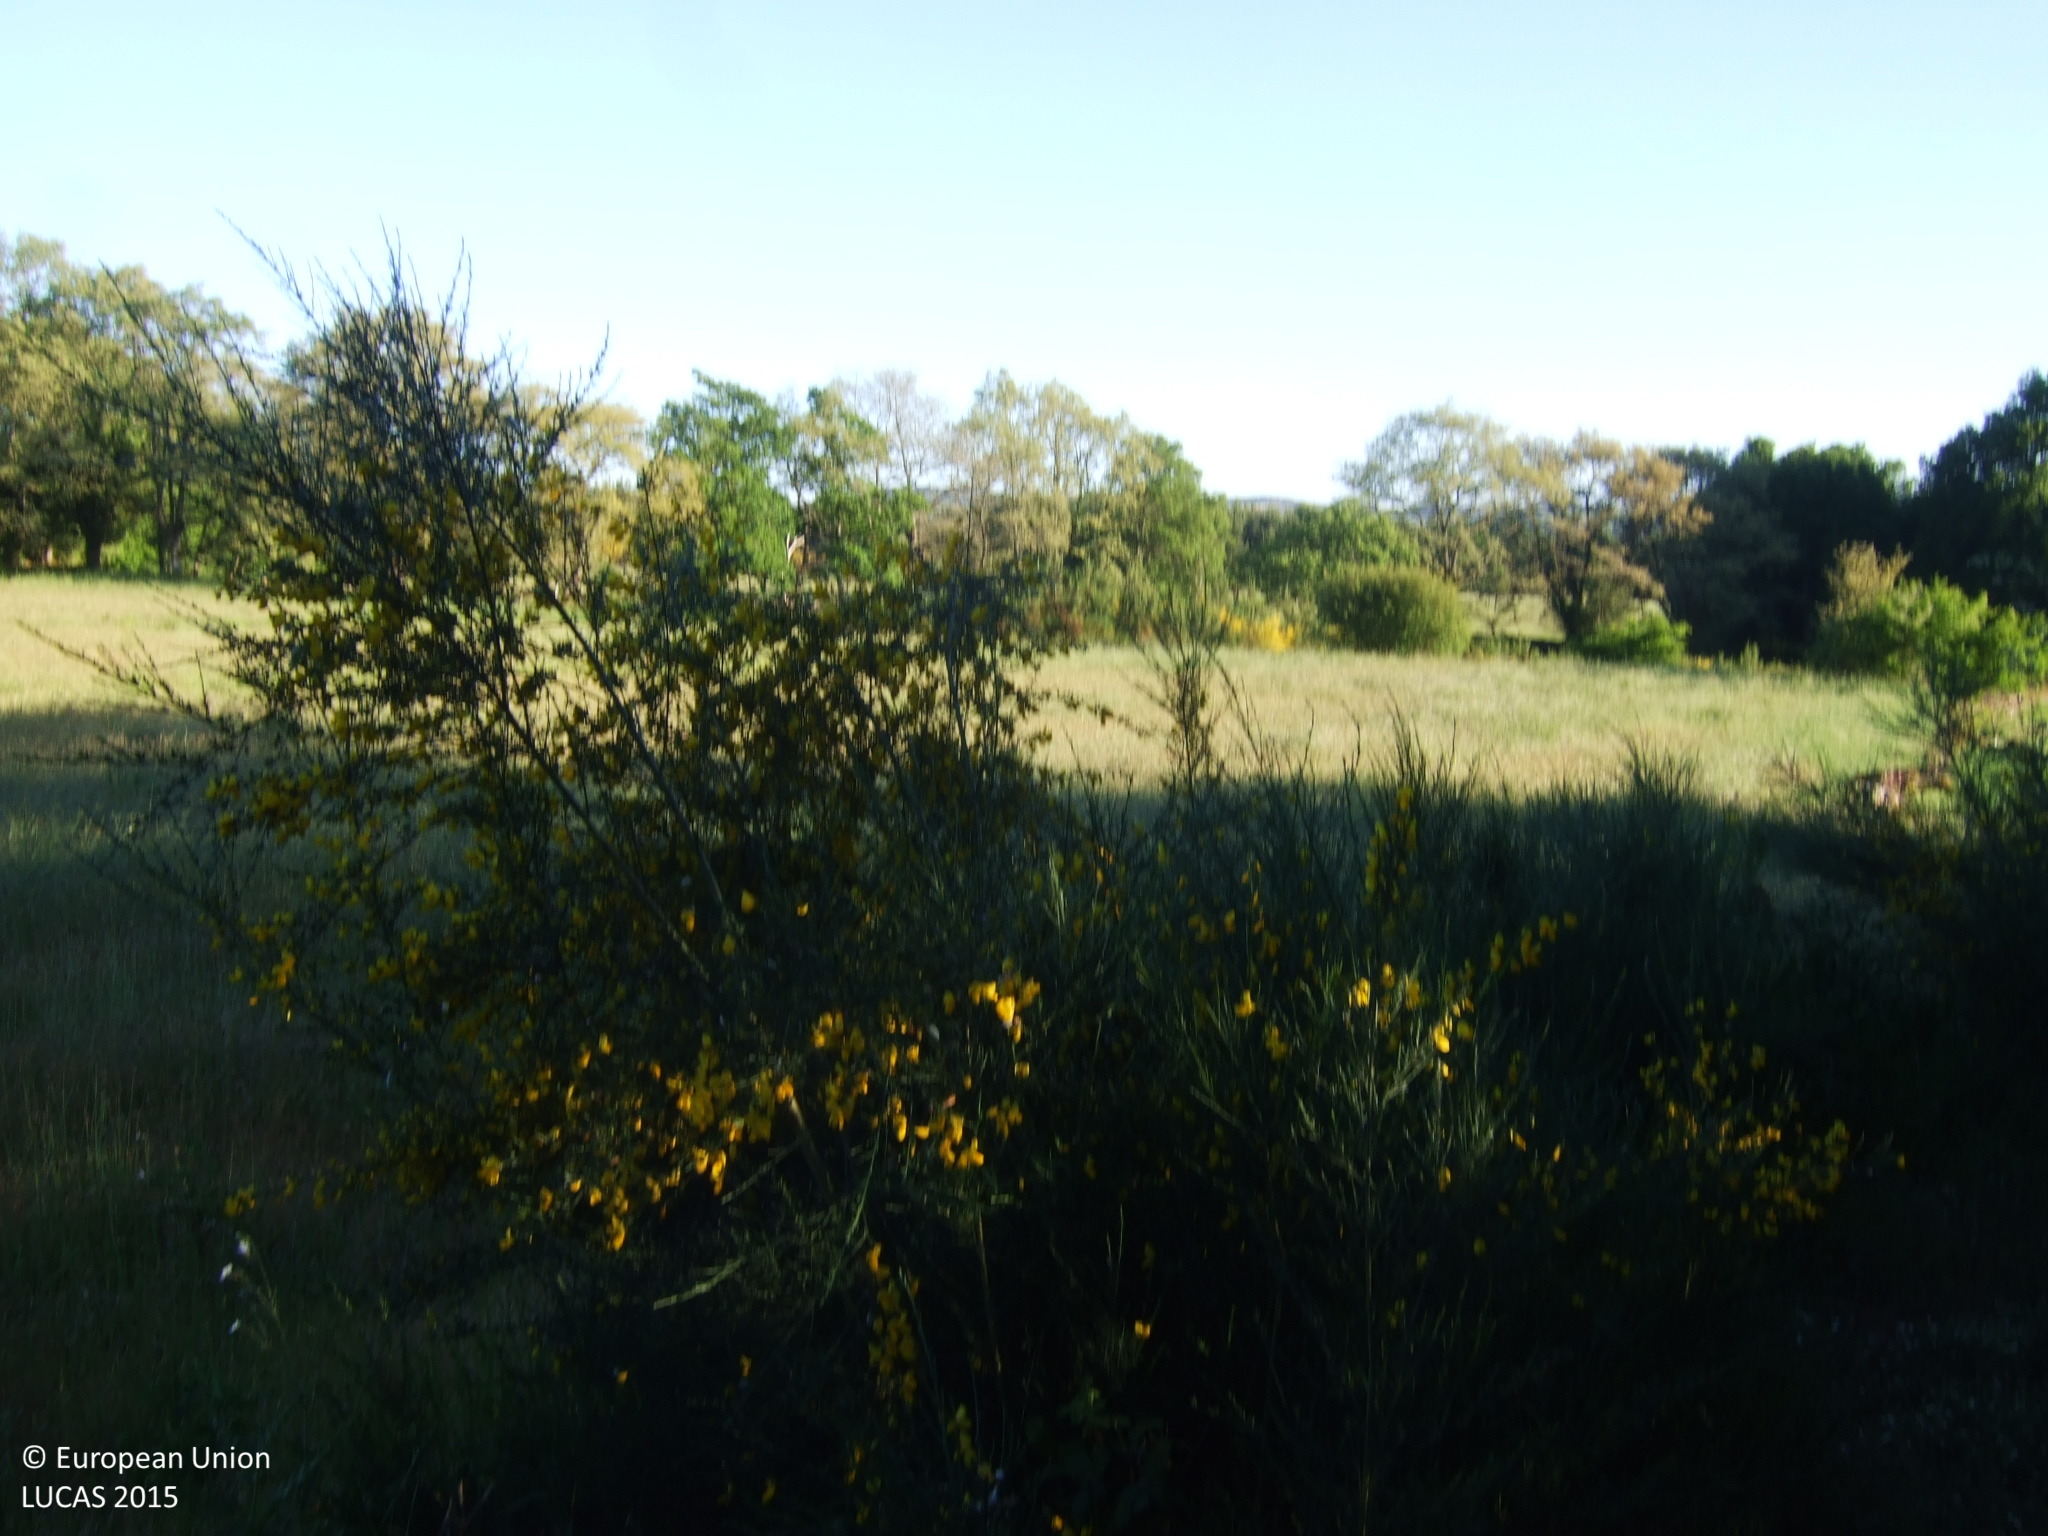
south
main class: Woodland
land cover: Broadleaved woodland
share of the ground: 25 - 50 %
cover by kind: broadleaved forest trees 50 %, herbaceous plants 30 %, shrubs 20 %
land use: Forestry
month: May
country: ES
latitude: 42.7556
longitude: -7.5083
